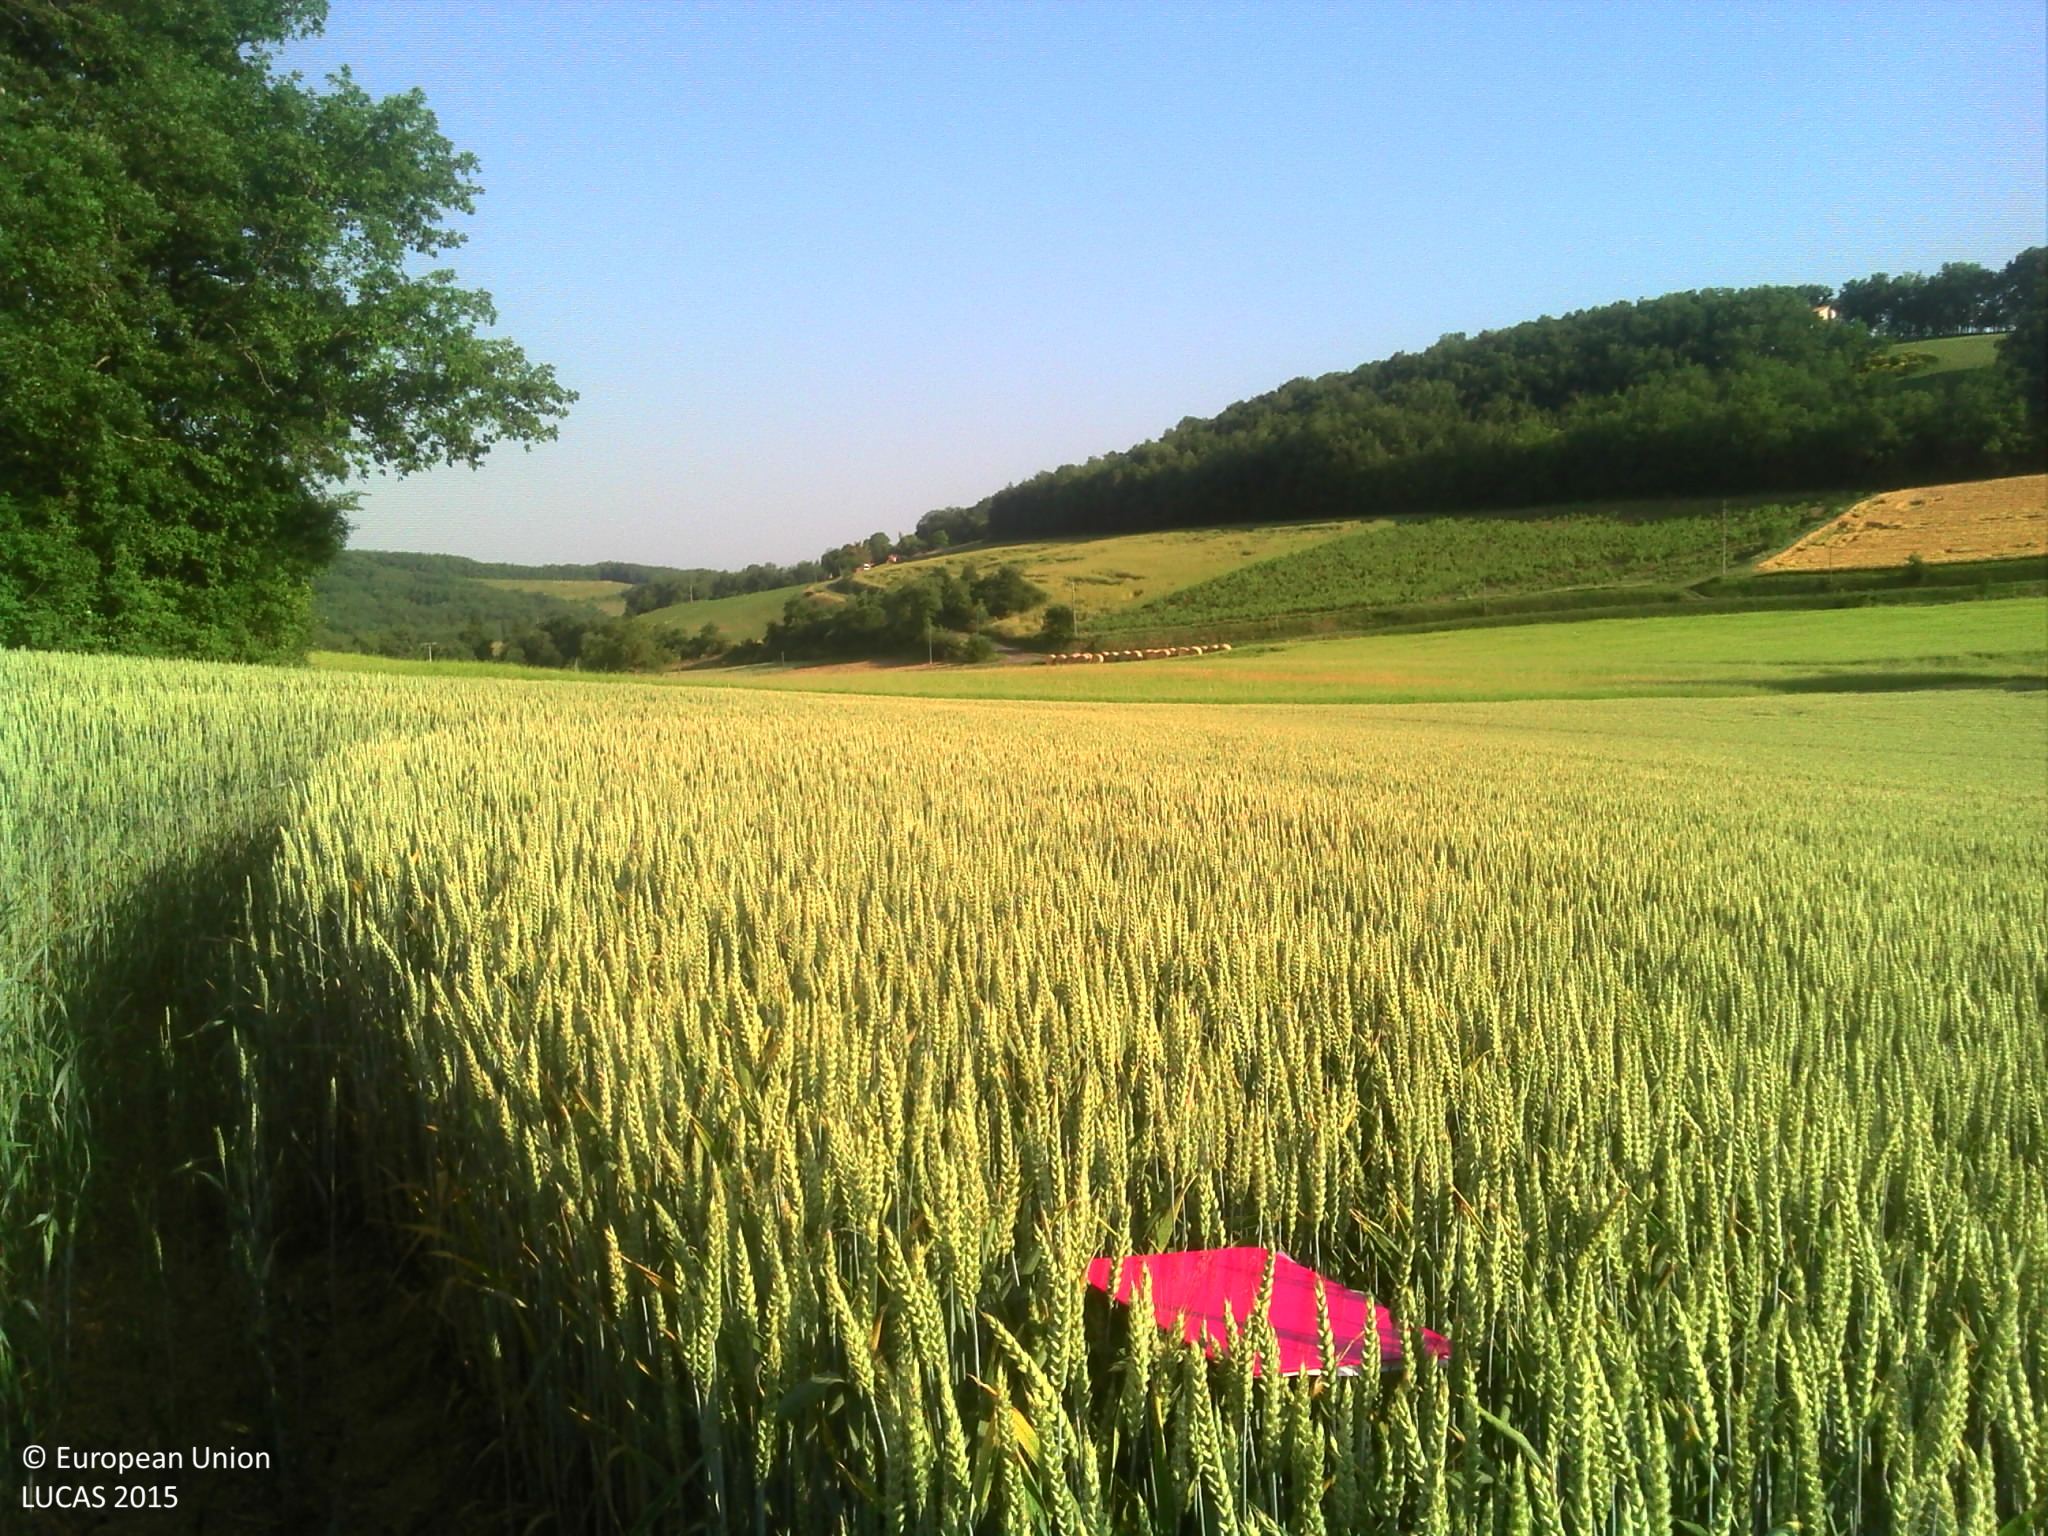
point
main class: Cropland
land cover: Common wheat
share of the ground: > 75 %
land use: Agriculture (excluding fallow land and kitchen gardens)
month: June
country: FR
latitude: 43.8860
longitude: 2.1000
